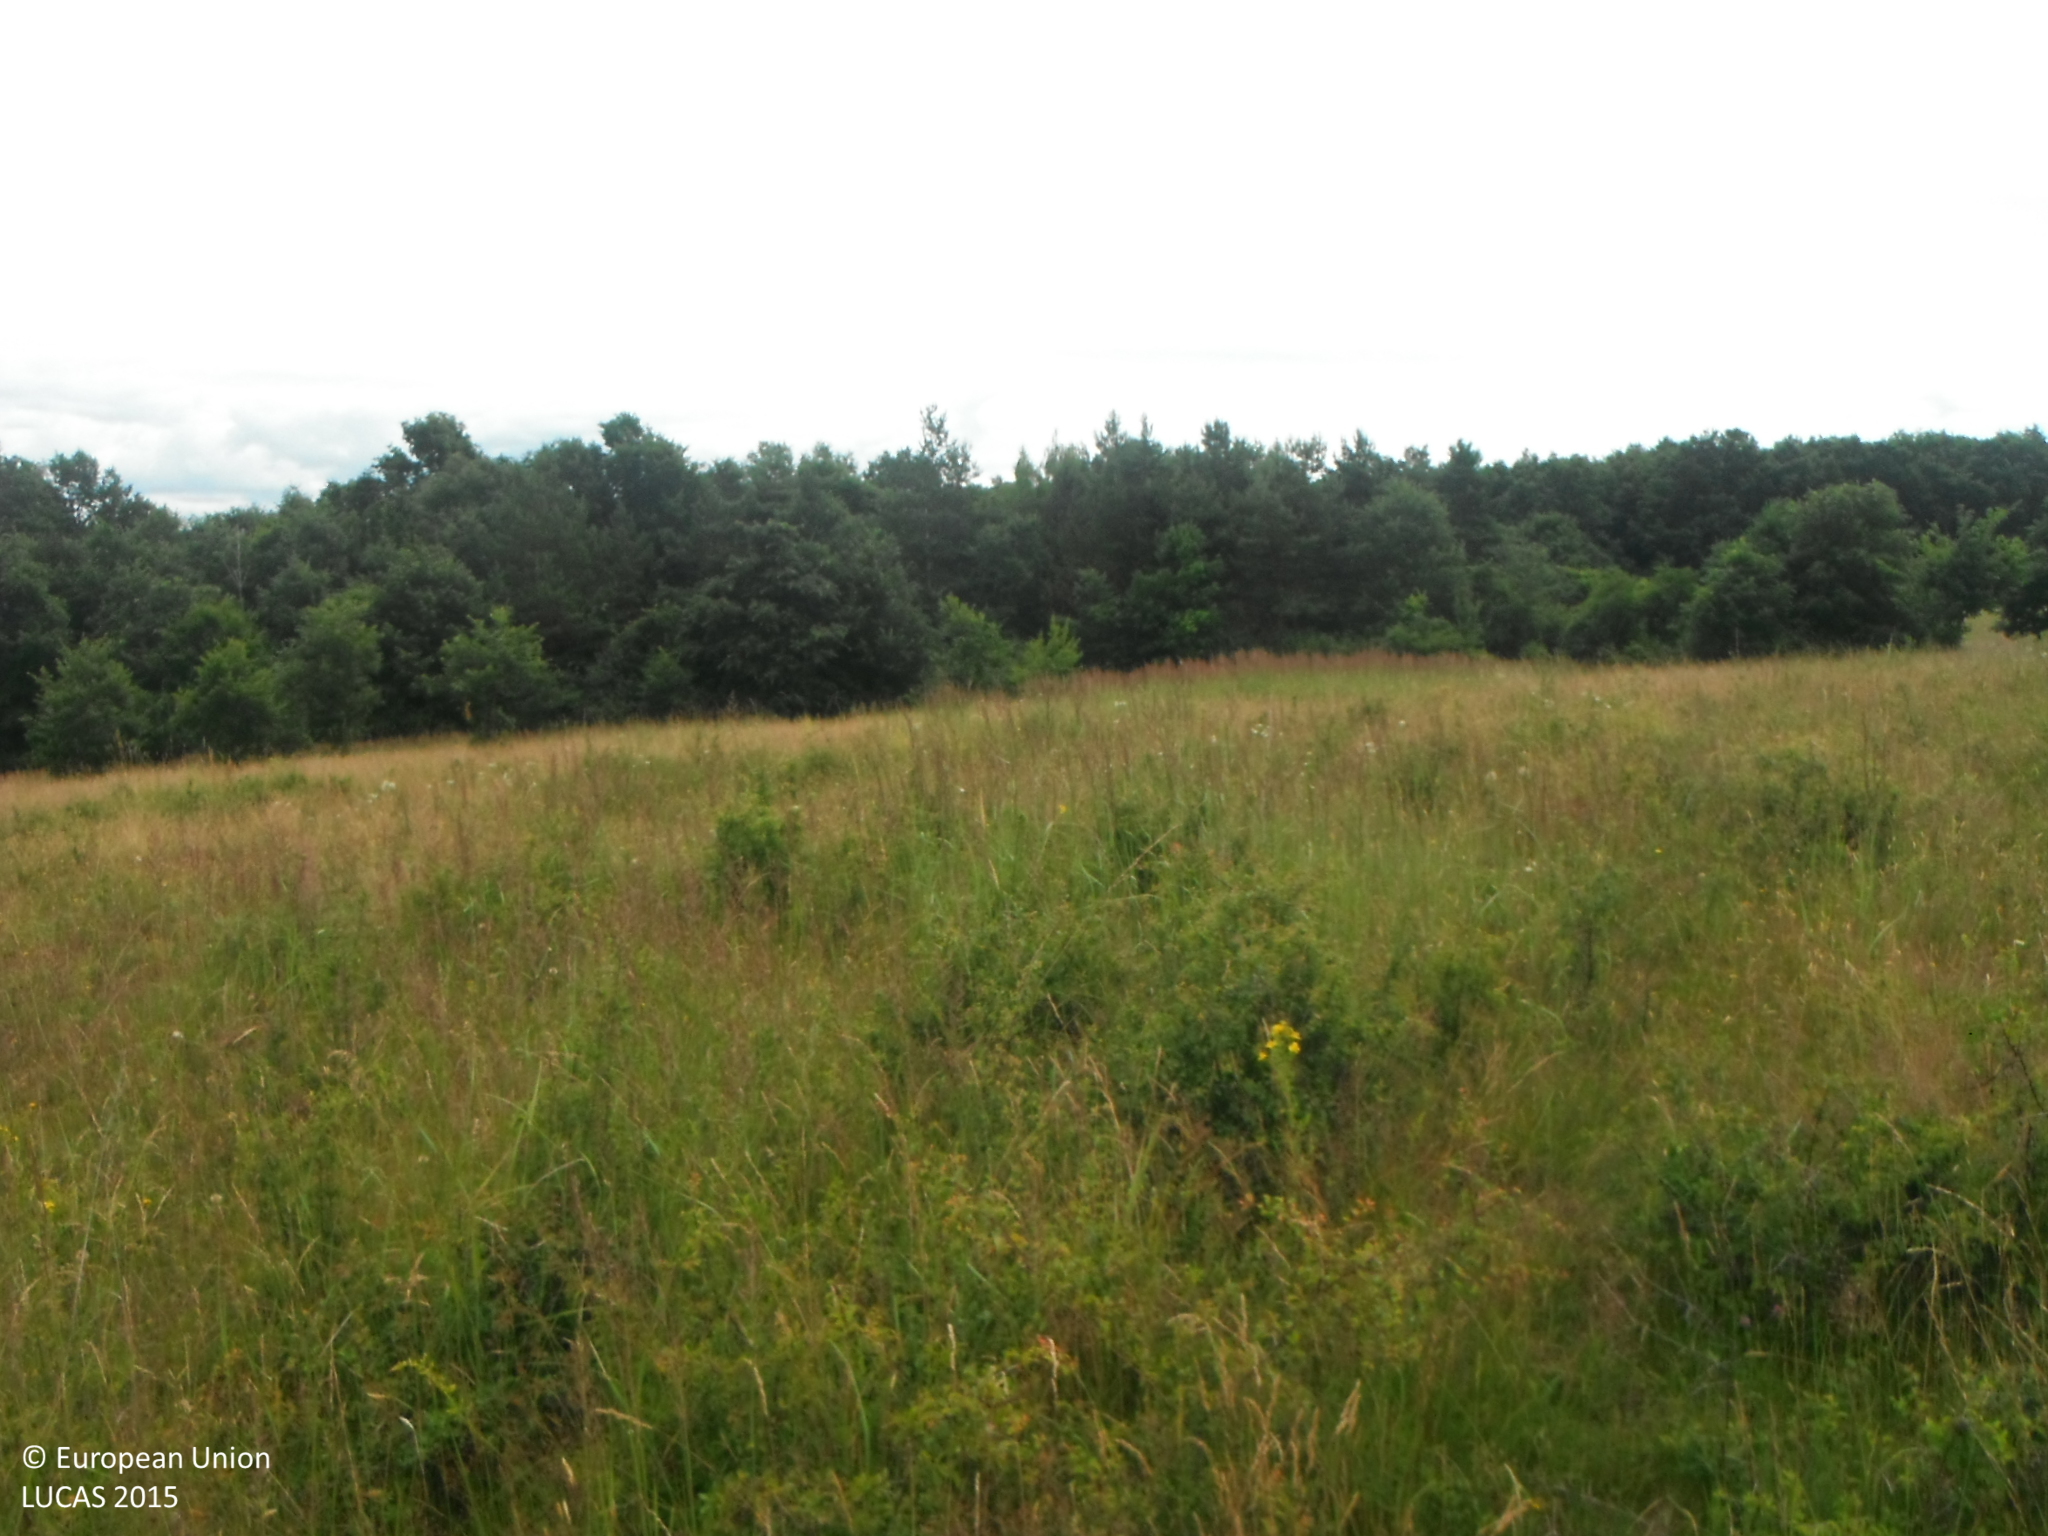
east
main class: Grassland
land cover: Grassland with sparse tree/shrub cover
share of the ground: > 75 %
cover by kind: herbaceous plants 90 %, broadleaved forest trees 5 %, shrubs 5 %
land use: Semi-natural and natural areas not in use
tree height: < 5 m
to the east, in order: Grassland with sparse tree/shrub cover; Shrubland without tree cover; Broadleaved woodland
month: June
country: SK
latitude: 48.5086
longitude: 20.2245
